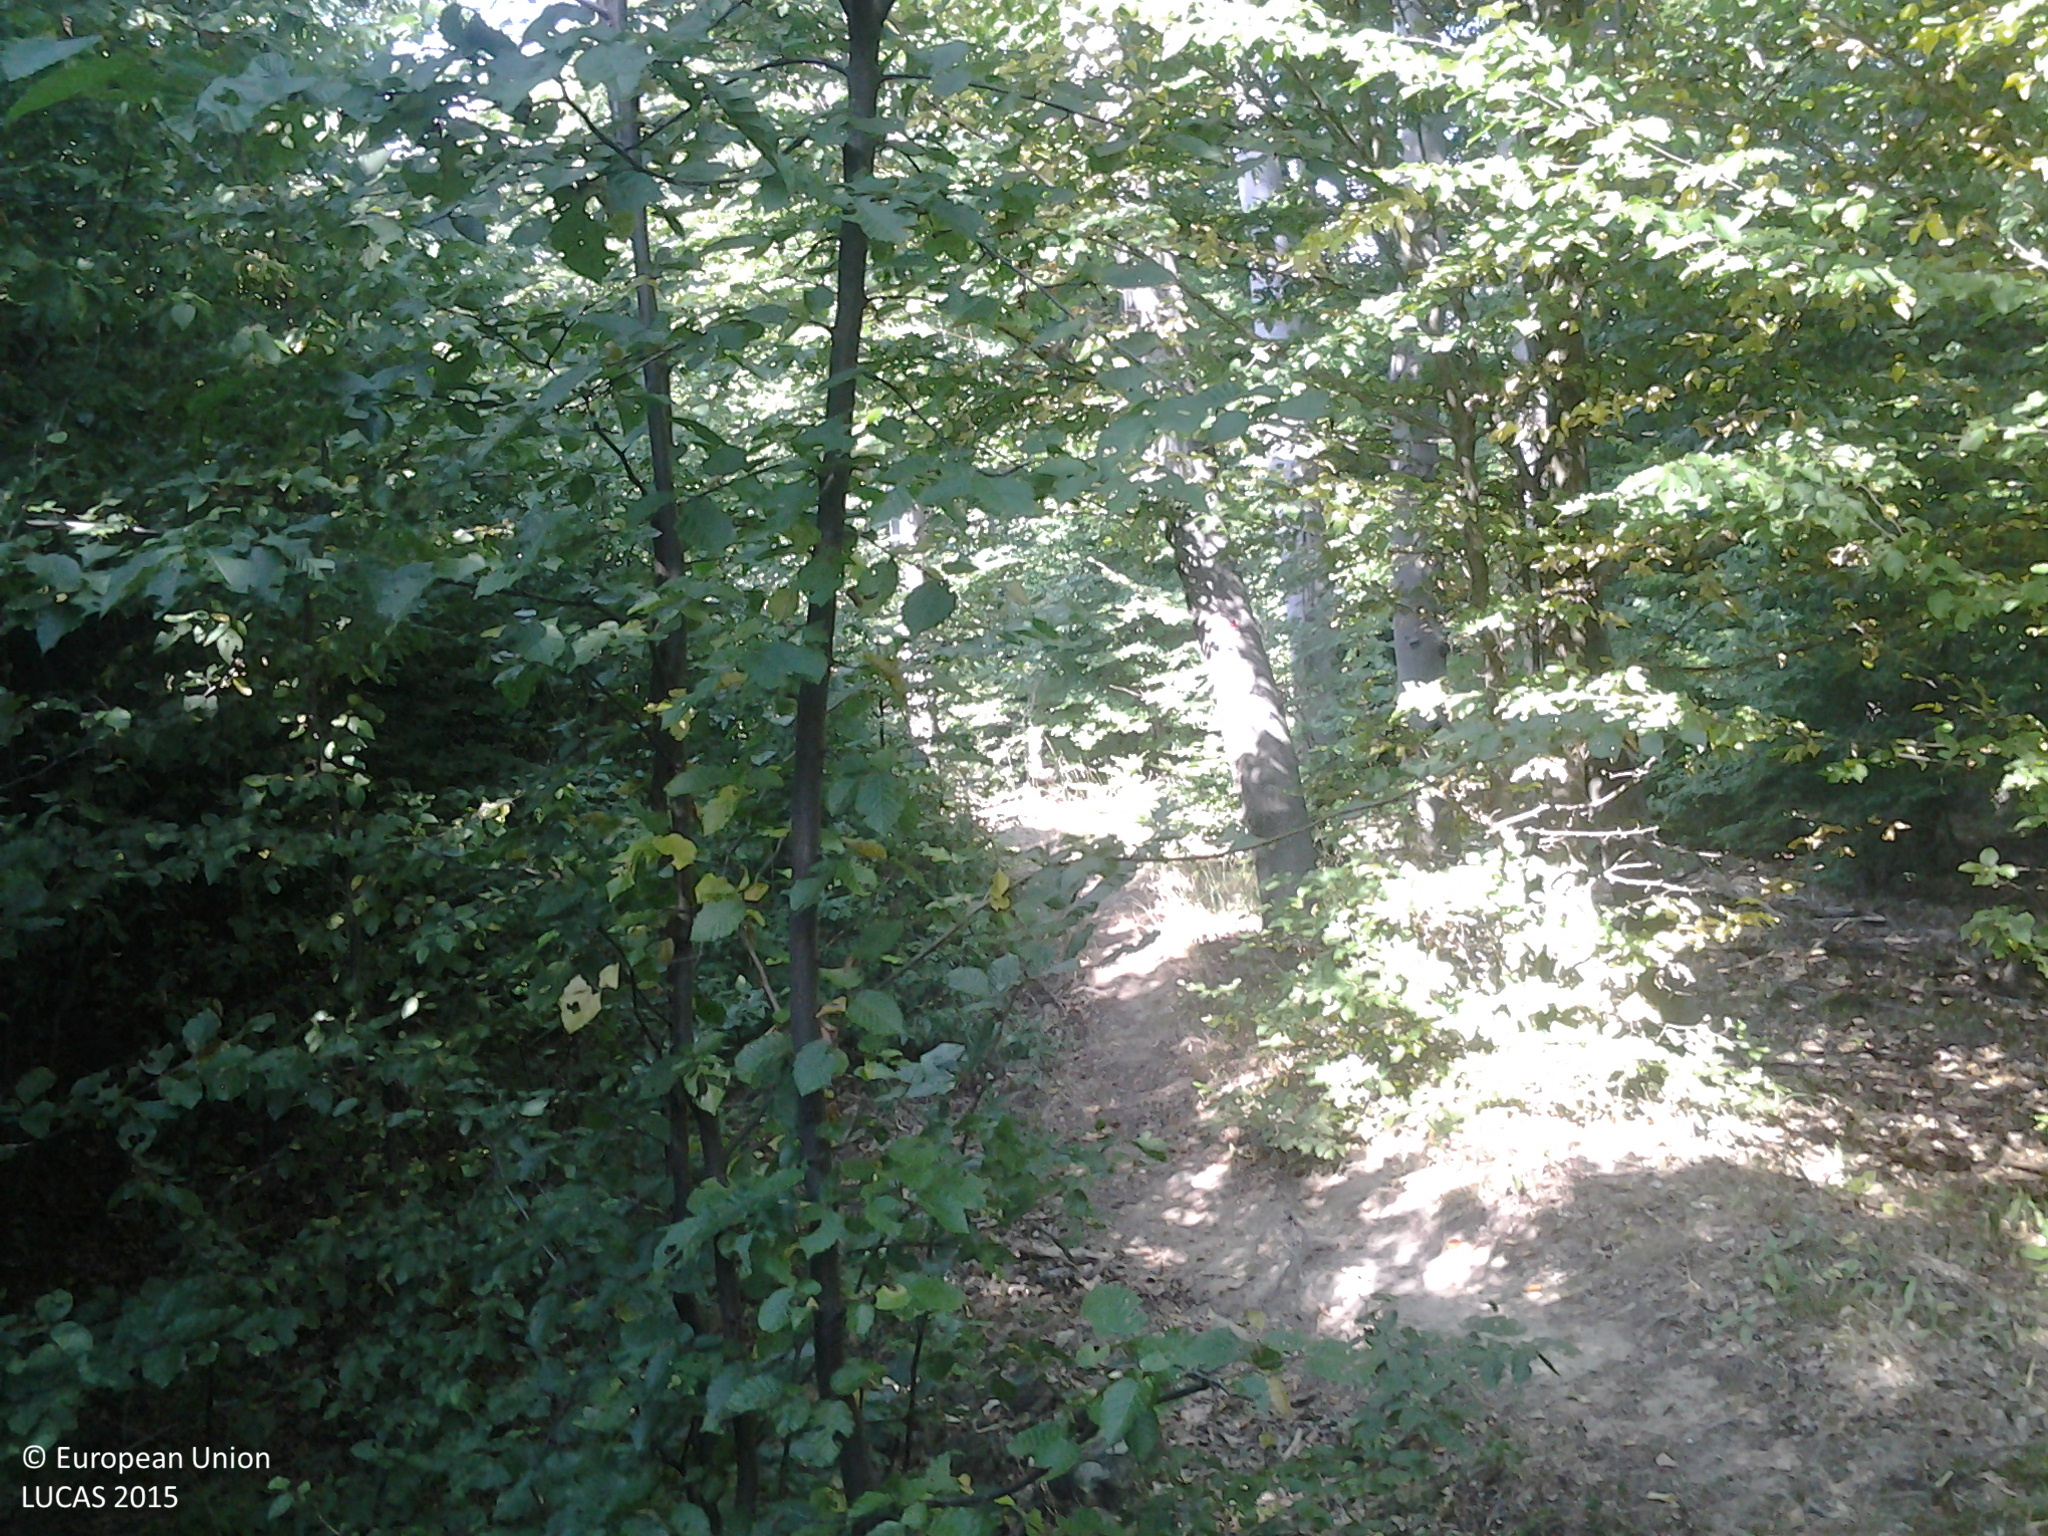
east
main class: Woodland
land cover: Broadleaved woodland
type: beech forest
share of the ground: > 75 %
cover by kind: broadleaved forest trees 85 %, shrubs 15 %
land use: Forestry
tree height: > 5 m
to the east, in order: Broadleaved woodland
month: August
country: HU
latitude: 47.9382
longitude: 19.9197
